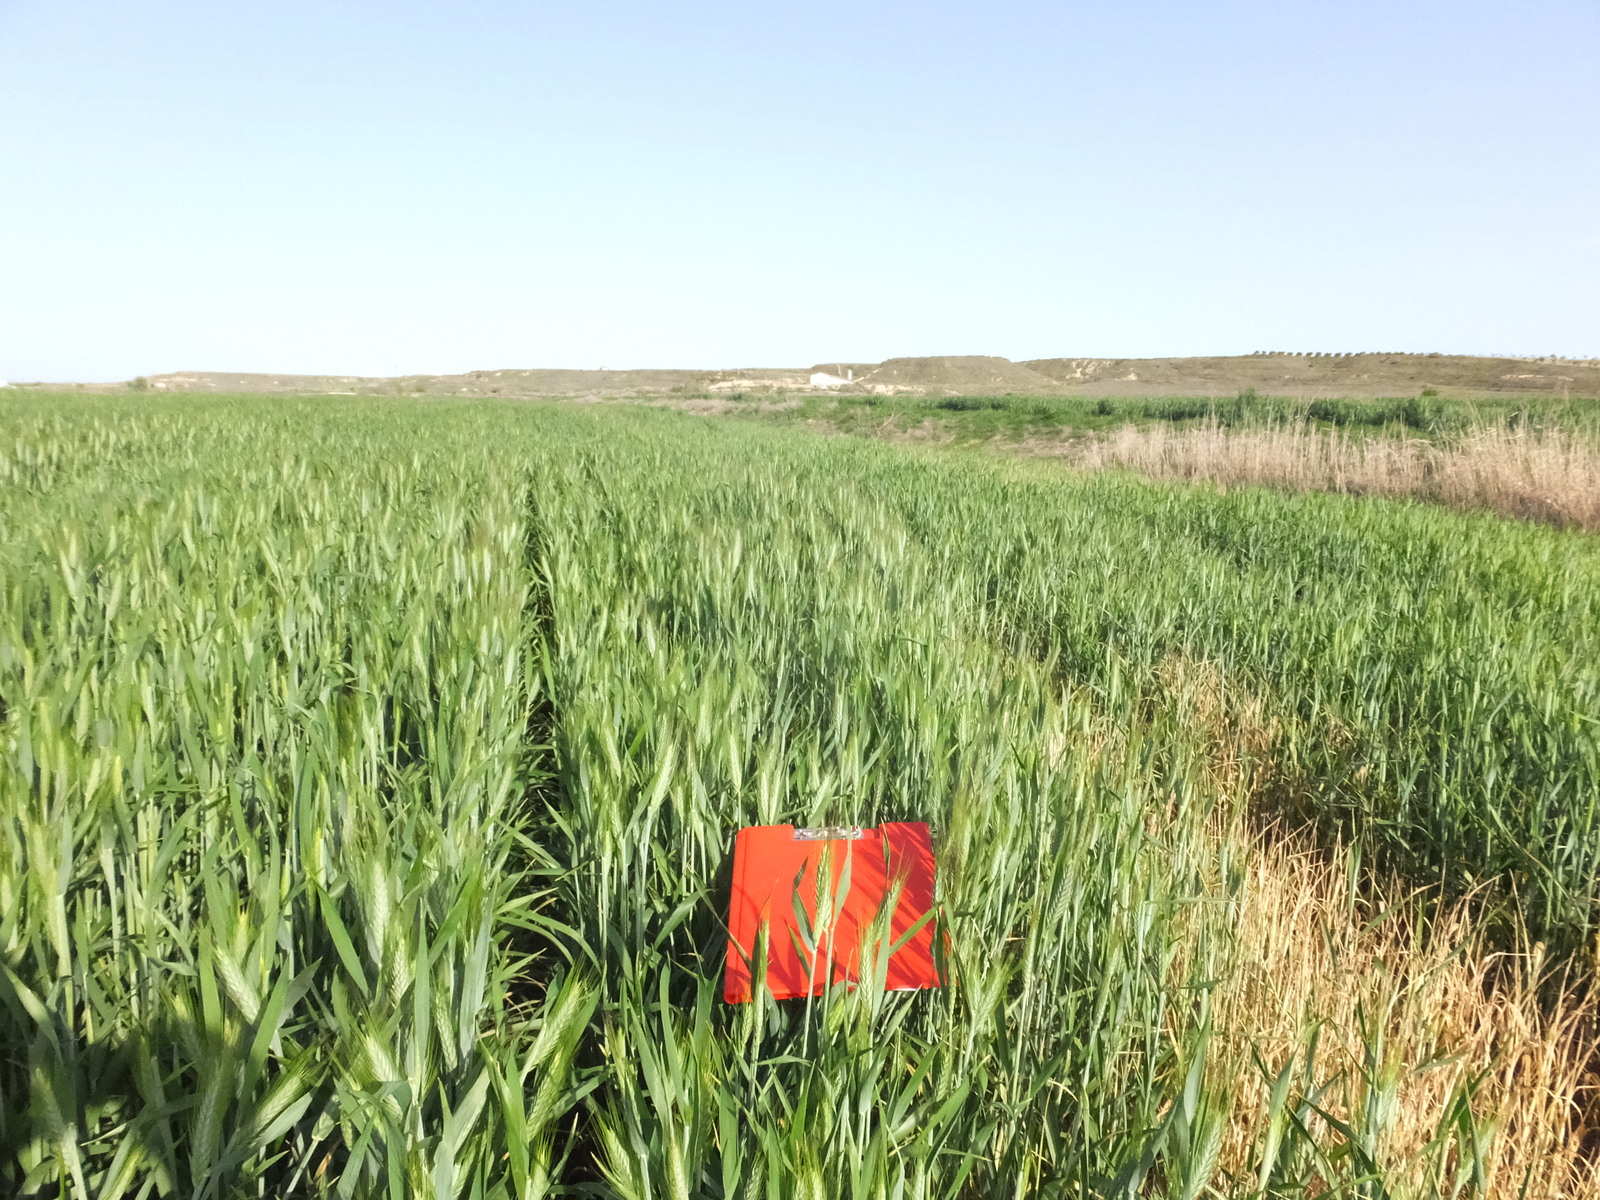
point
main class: Cropland
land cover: Durum wheat
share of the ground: > 75 %
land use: Agriculture (excluding fallow land and kitchen gardens)
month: April
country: ES
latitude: 41.7763
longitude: -0.3535
